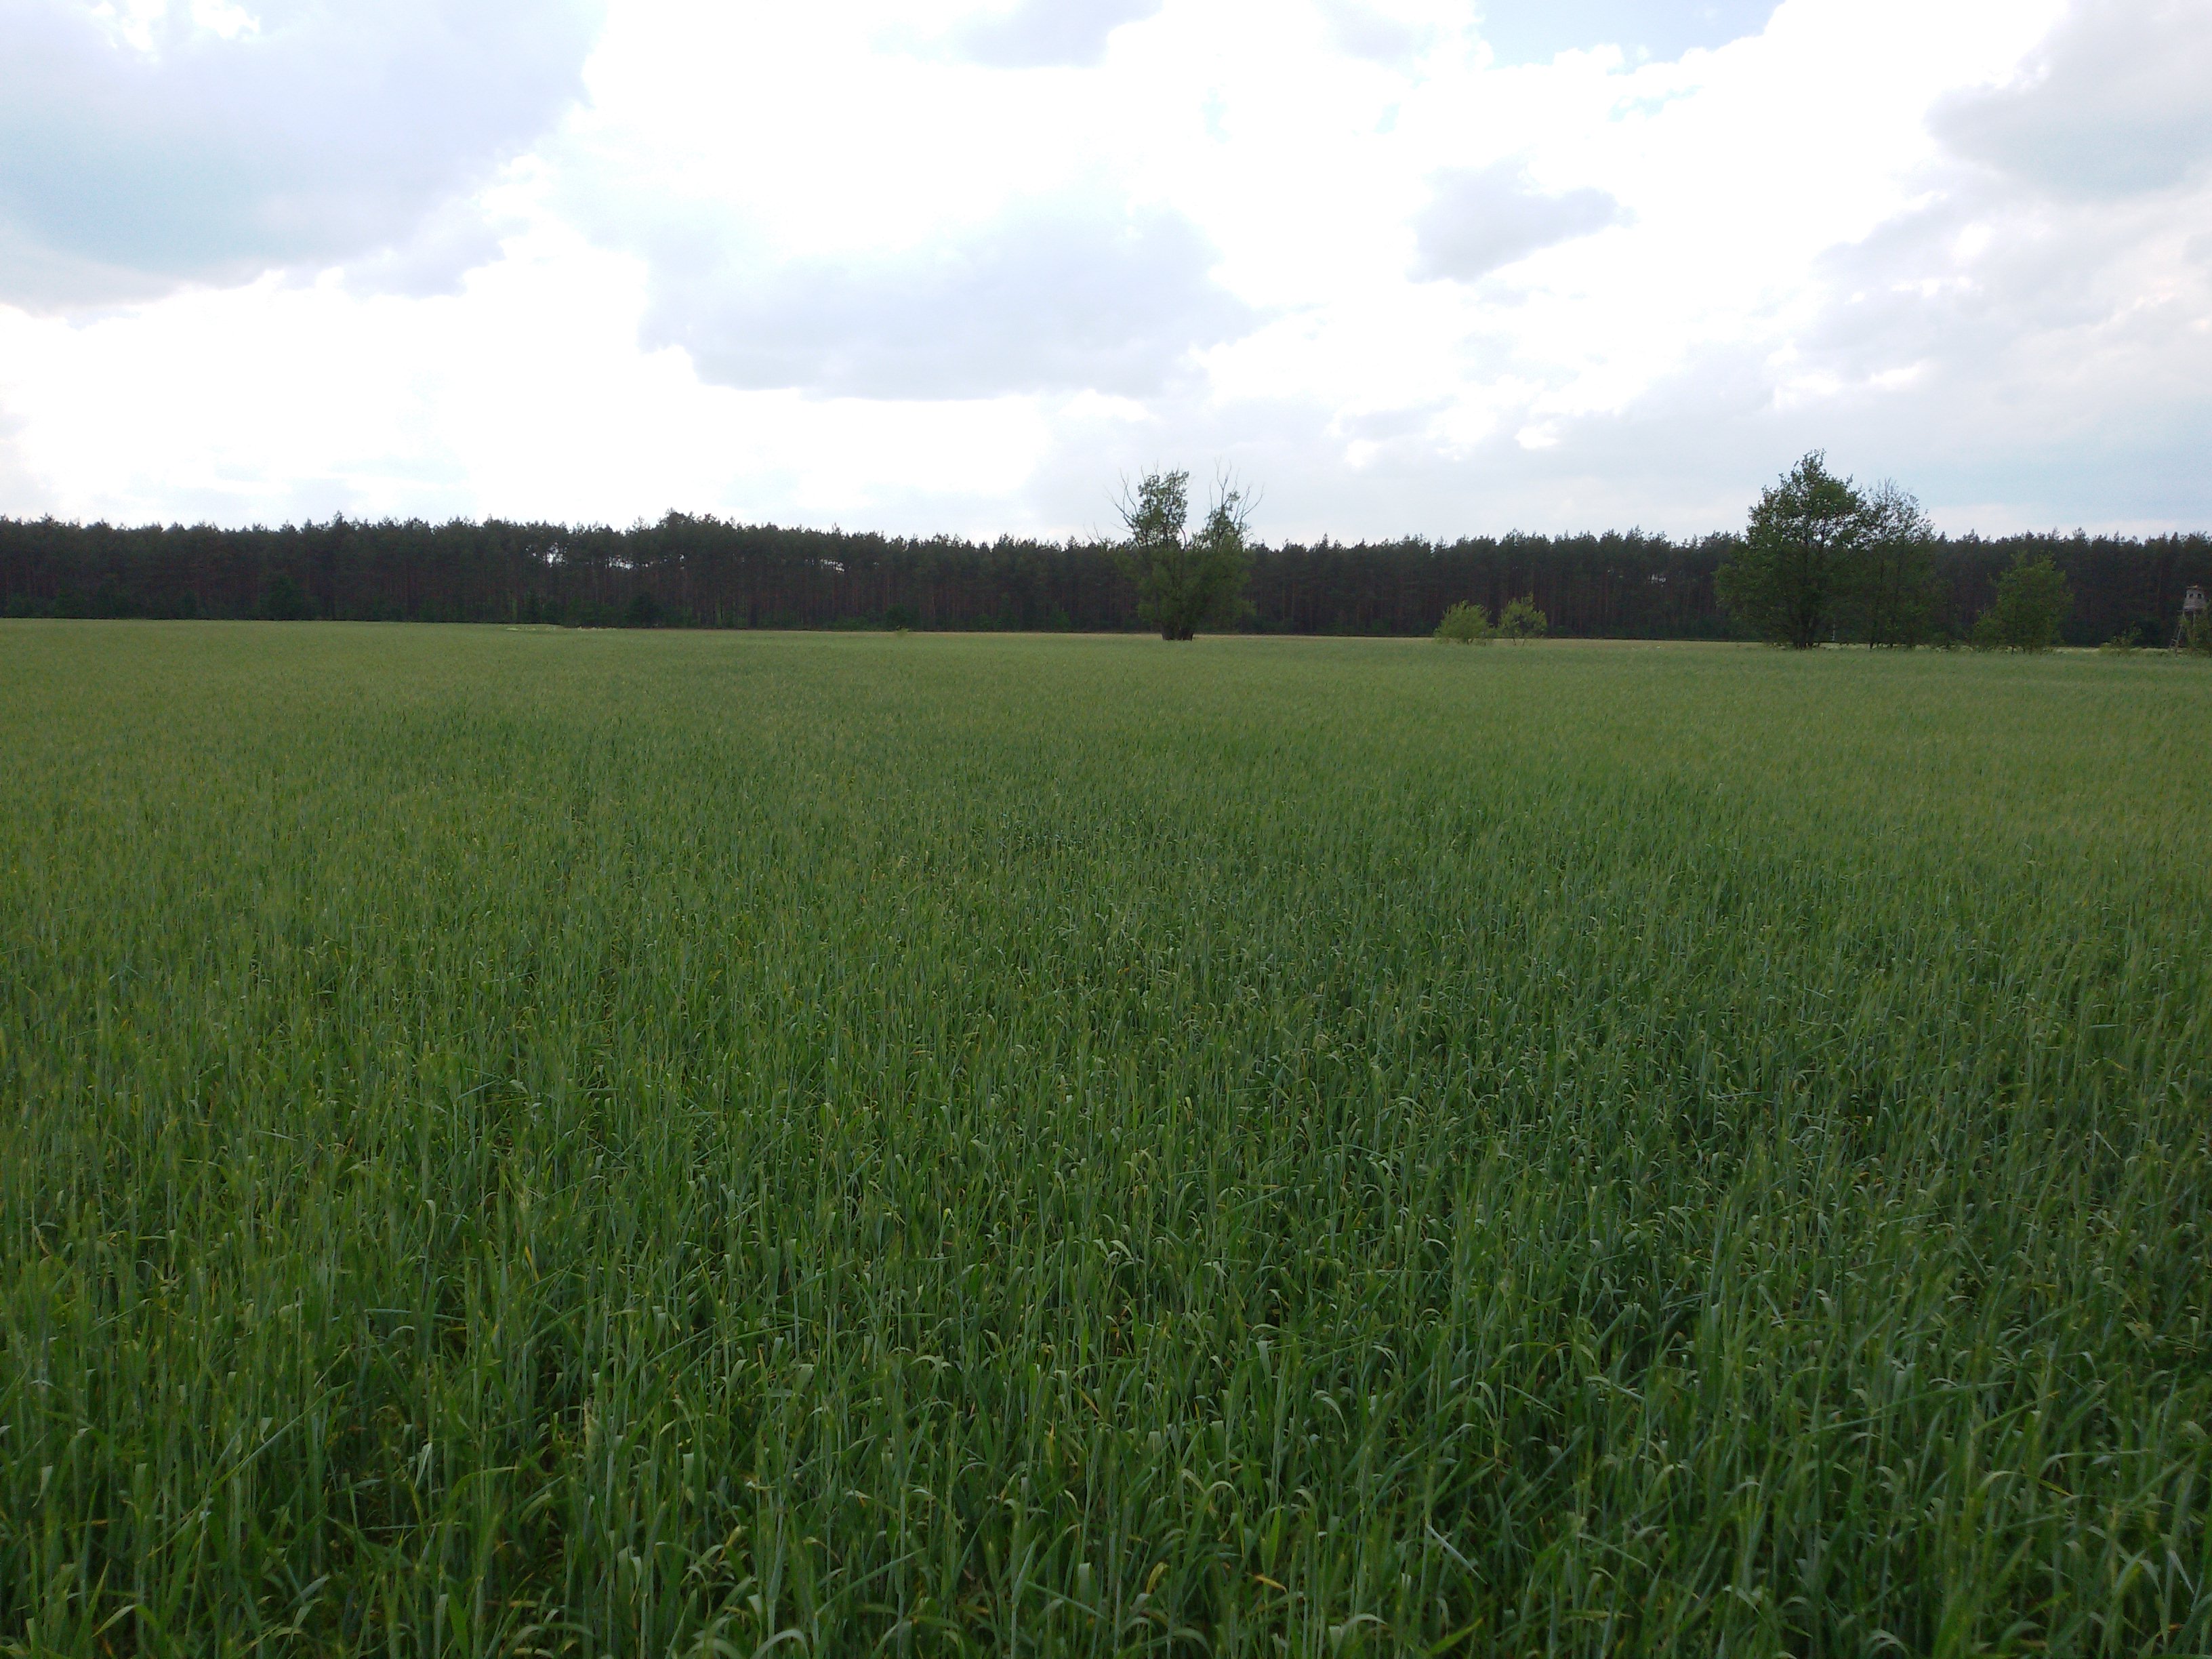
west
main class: Cropland
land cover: Common wheat
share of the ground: > 75 %
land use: Agriculture (excluding fallow land and kitchen gardens)
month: May
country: PL
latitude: 53.4065
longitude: 21.0095
